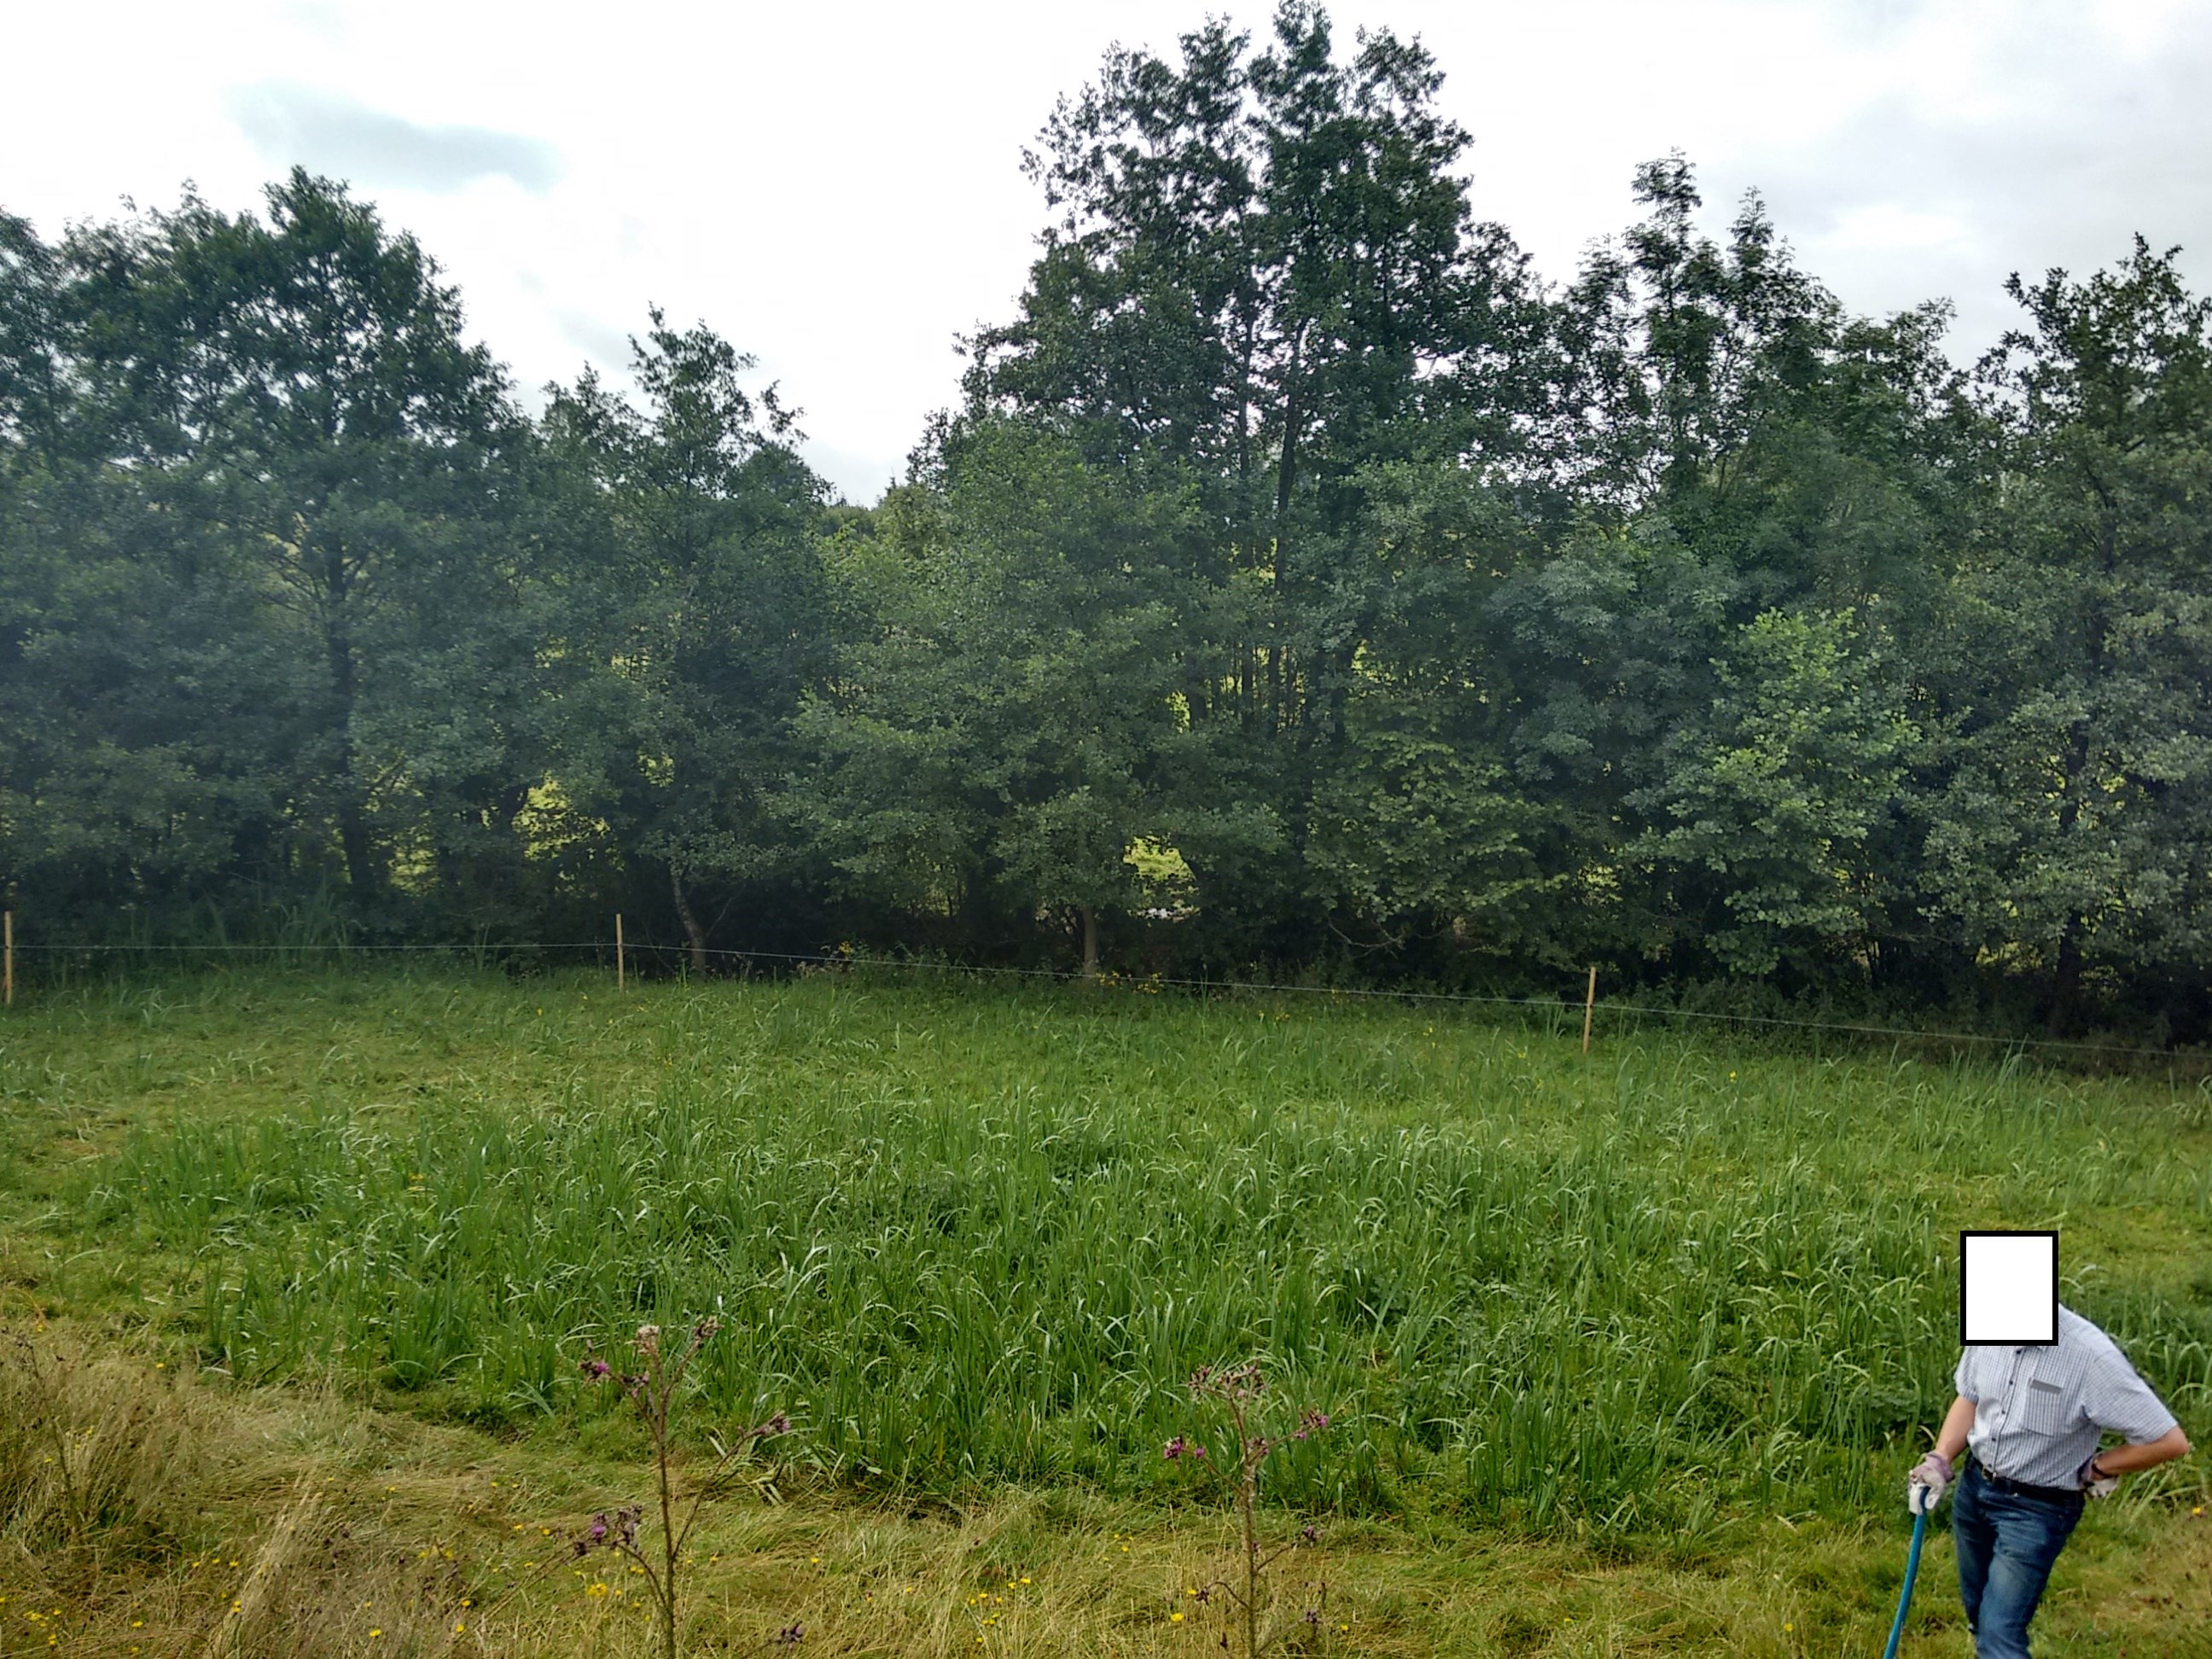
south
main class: Grassland
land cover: Grassland without tree/shrub cover
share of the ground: > 75 %
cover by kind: herbaceous plants 100 %
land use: Agriculture (excluding fallow land and kitchen gardens)
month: August
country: GB
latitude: 54.3719
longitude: -6.7730
